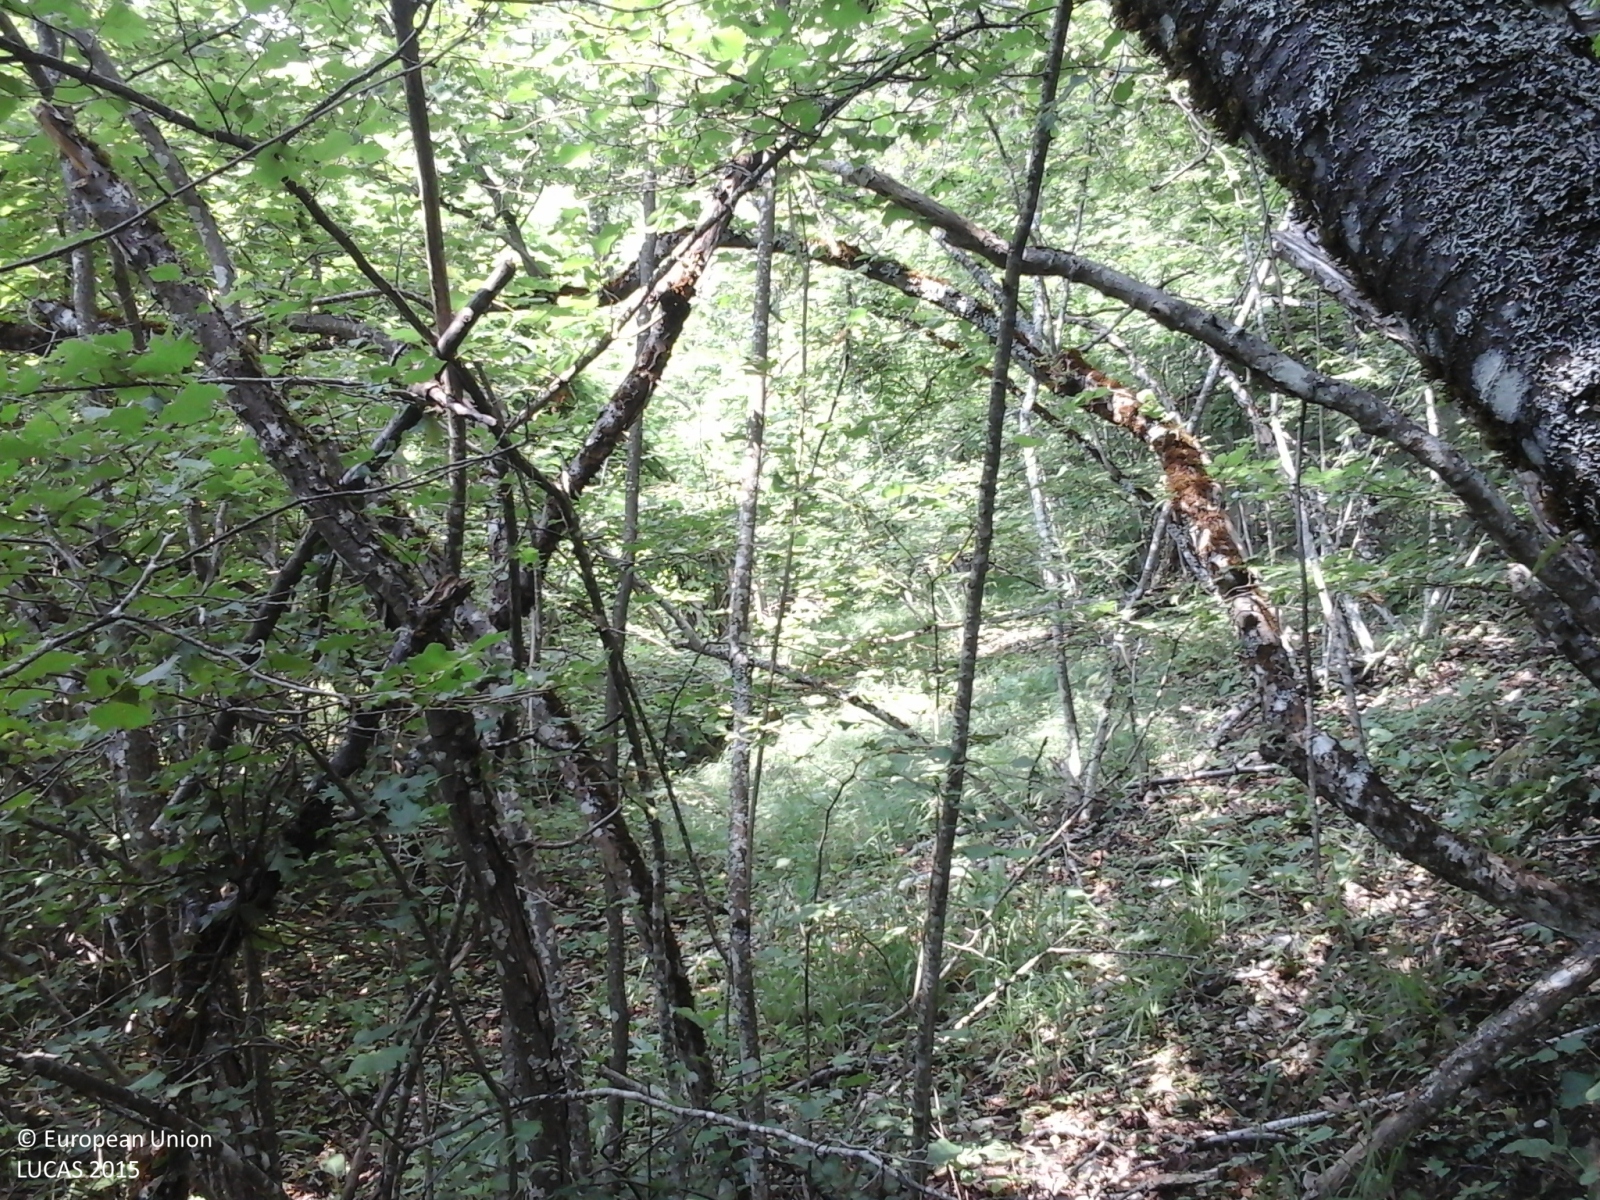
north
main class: Woodland
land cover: Broadleaved woodland
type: mesophytic deciduous forest
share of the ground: > 75 %
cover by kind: broadleaved forest trees 100 %
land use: Forestry
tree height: > 5 m
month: July
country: IT
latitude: 44.7254
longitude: 9.1054
